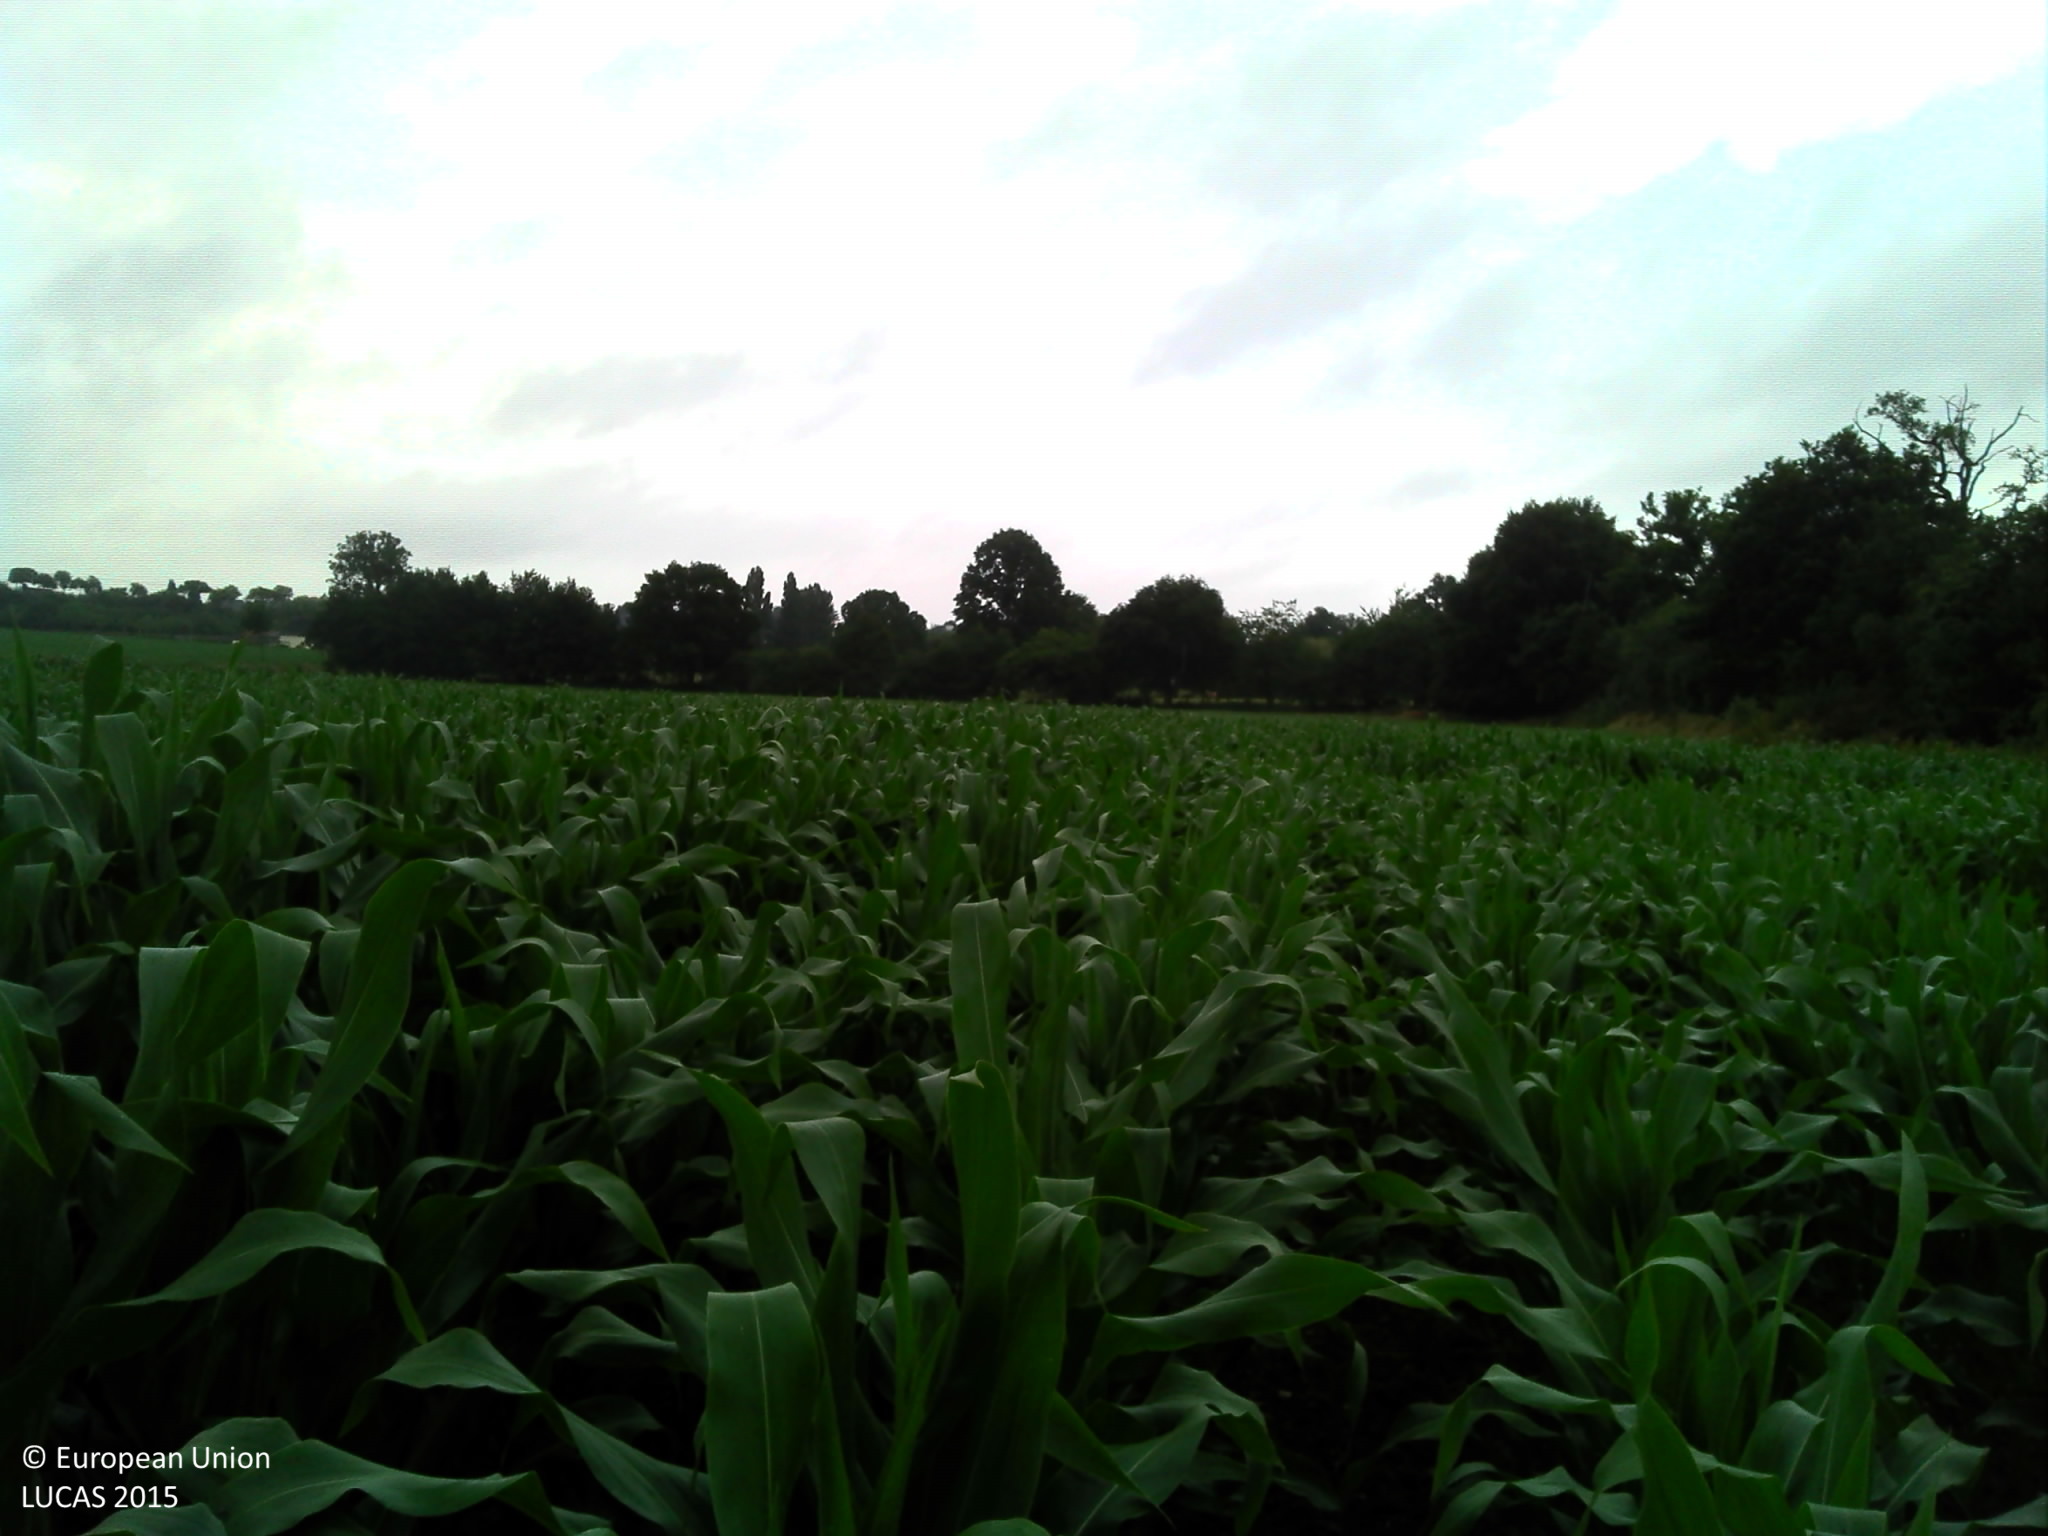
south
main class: Cropland
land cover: Maize
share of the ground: > 75 %
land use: Agriculture (excluding fallow land and kitchen gardens)
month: July
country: FR
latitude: 47.9025
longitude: -1.4009
